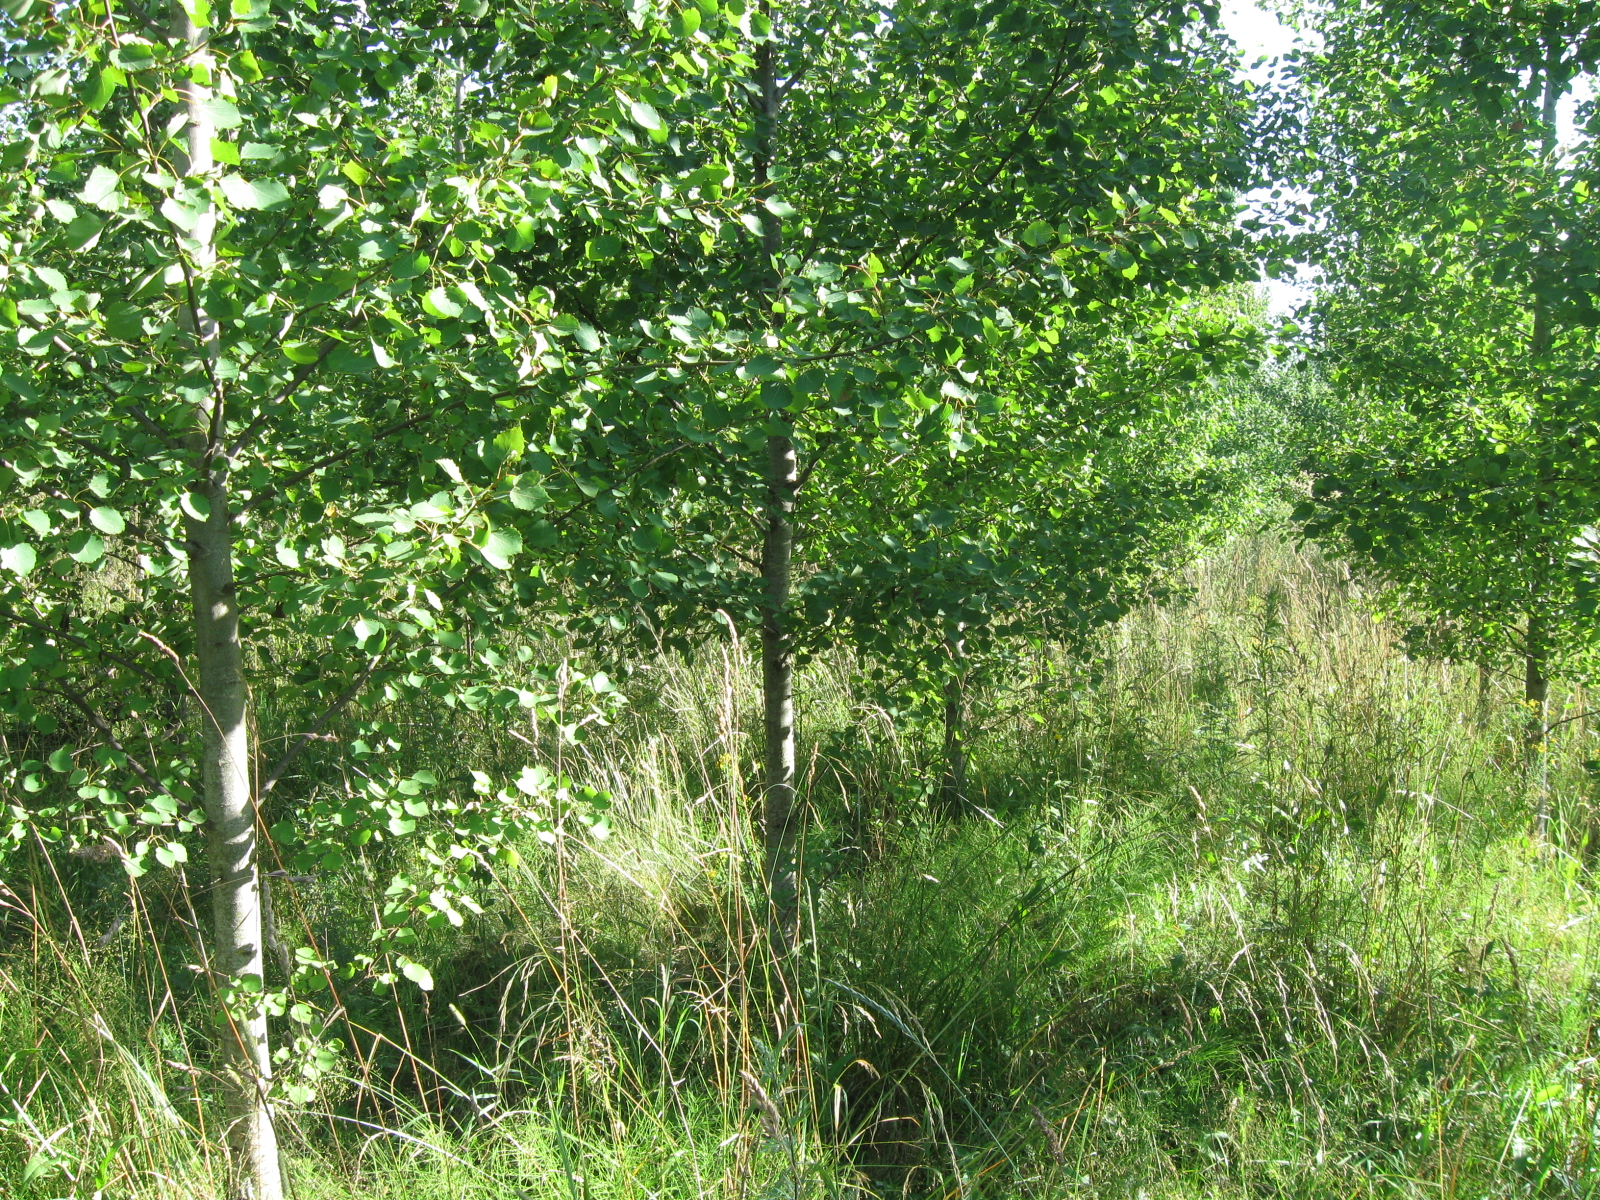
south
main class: Woodland
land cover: Broadleaved woodland
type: non-riverine alder, birch or aspen forest
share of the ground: 50 - 75 %
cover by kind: broadleaved forest trees 55 %, herbaceous plants 45 %
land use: Forestry
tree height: < 5 m
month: July
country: LT
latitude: 54.3053
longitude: 23.4675
